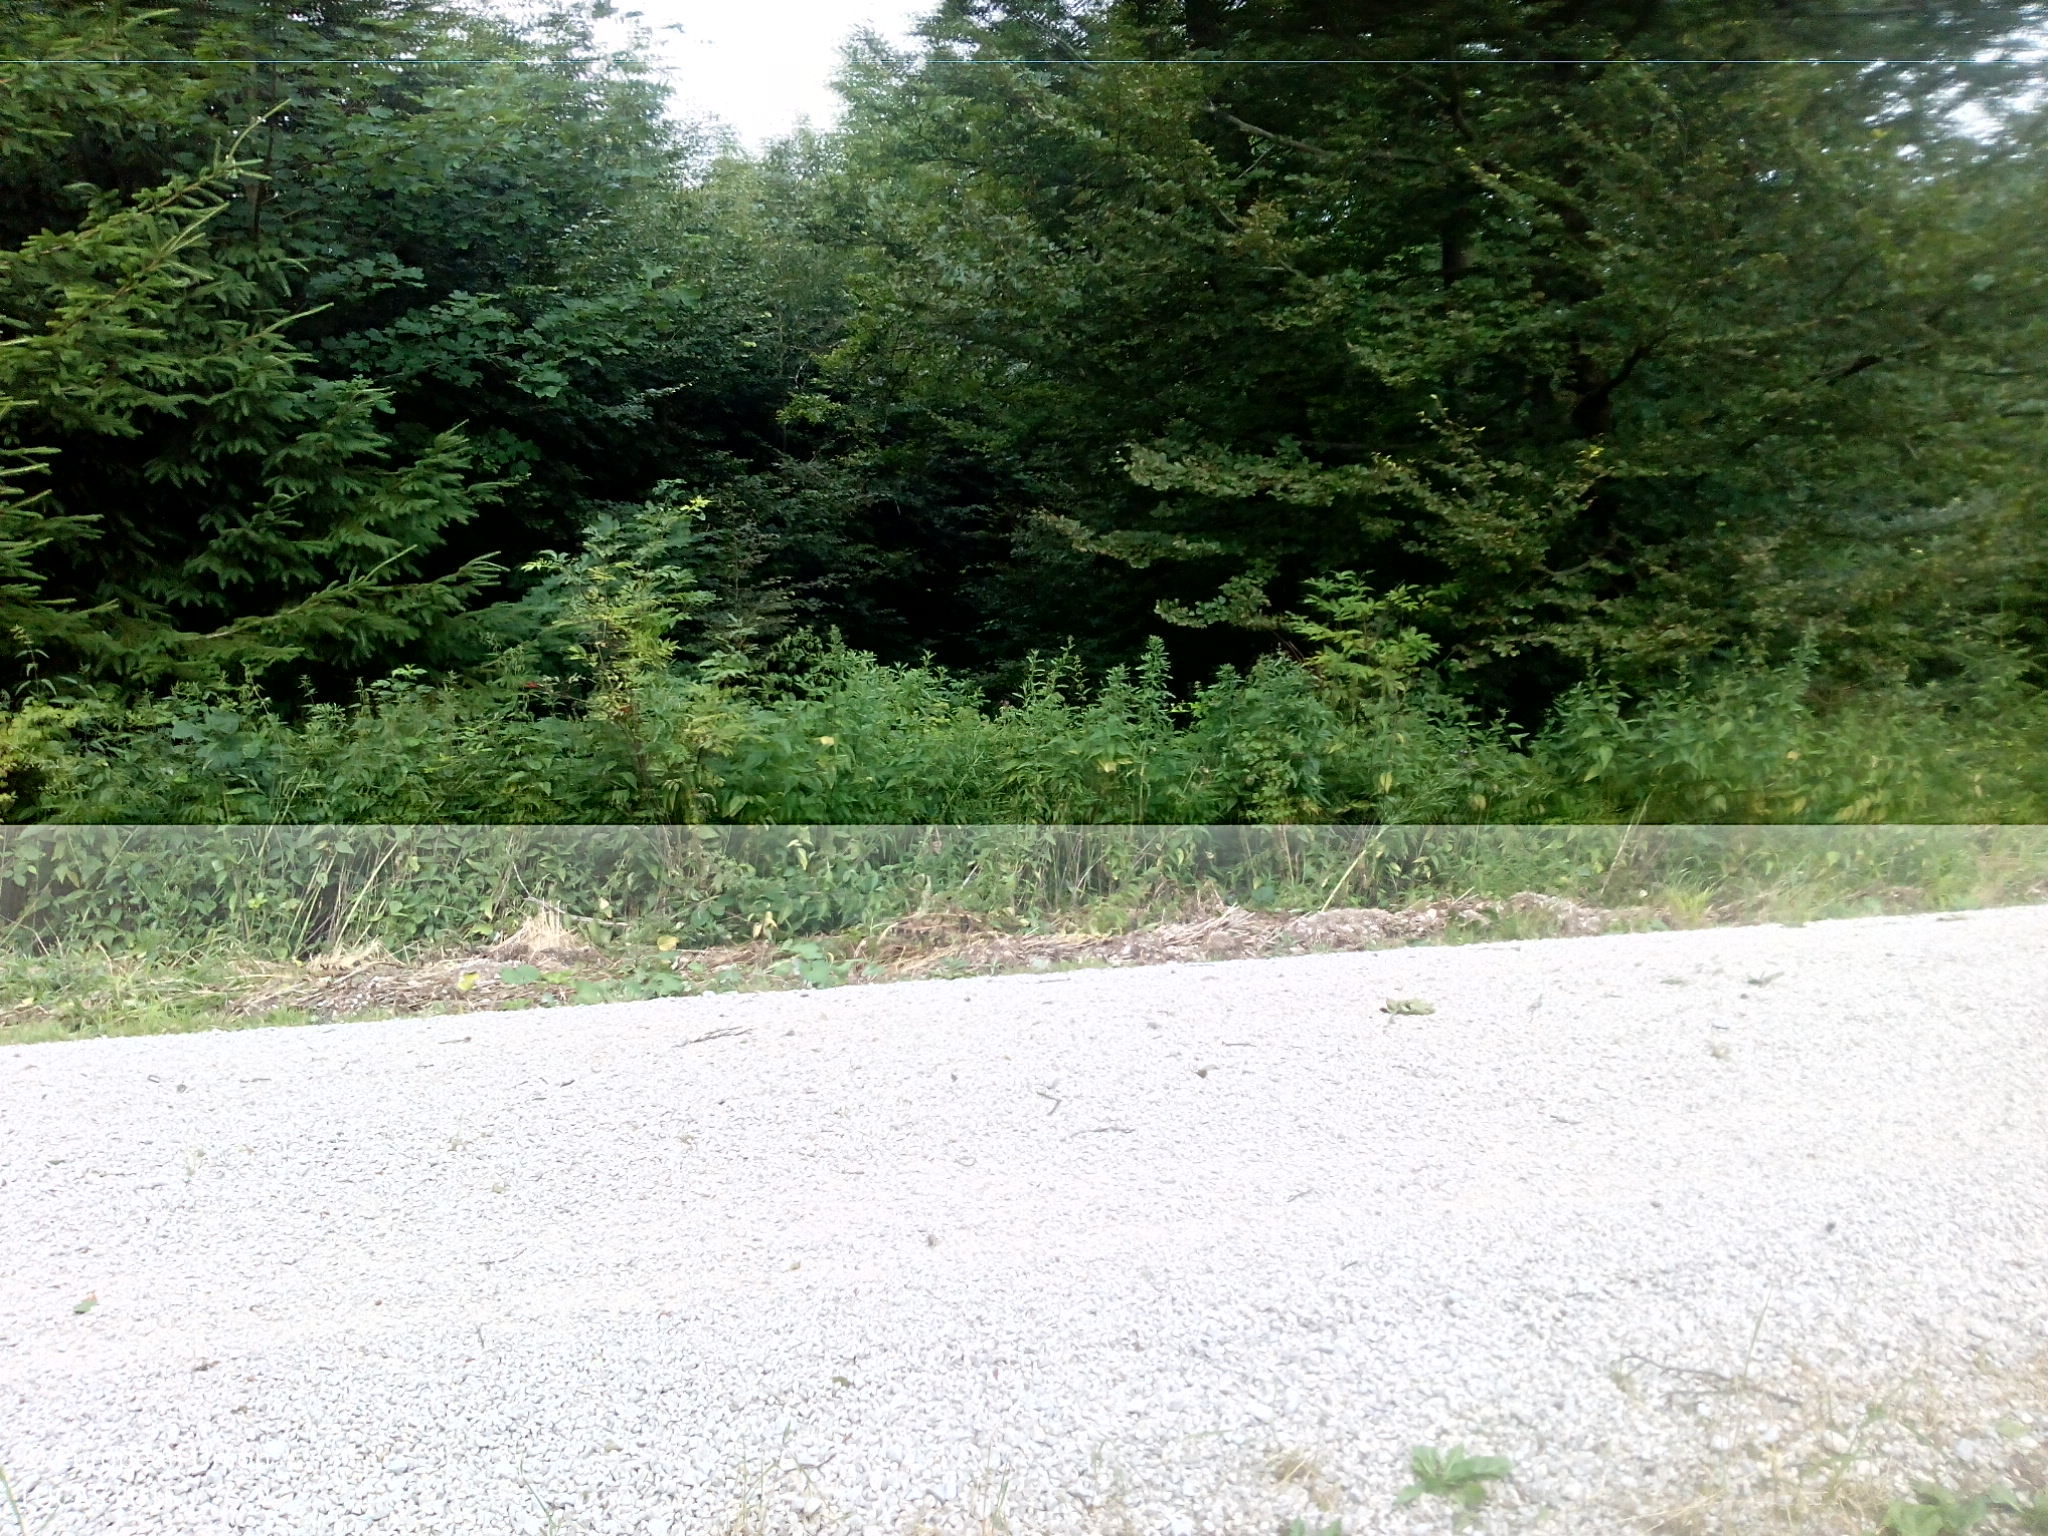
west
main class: Woodland
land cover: Broadleaved woodland
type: mesophytic deciduous forest
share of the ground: 50 - 75 %
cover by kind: broadleaved forest trees 60 %, herbaceous plants 20 %, coniferous forest trees 10 %, lichens and mosses 5 %, unconsolidated bare surface 5 %
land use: Forestry
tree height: > 5 m
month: July
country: DE
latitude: 48.8614
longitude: 11.4852
